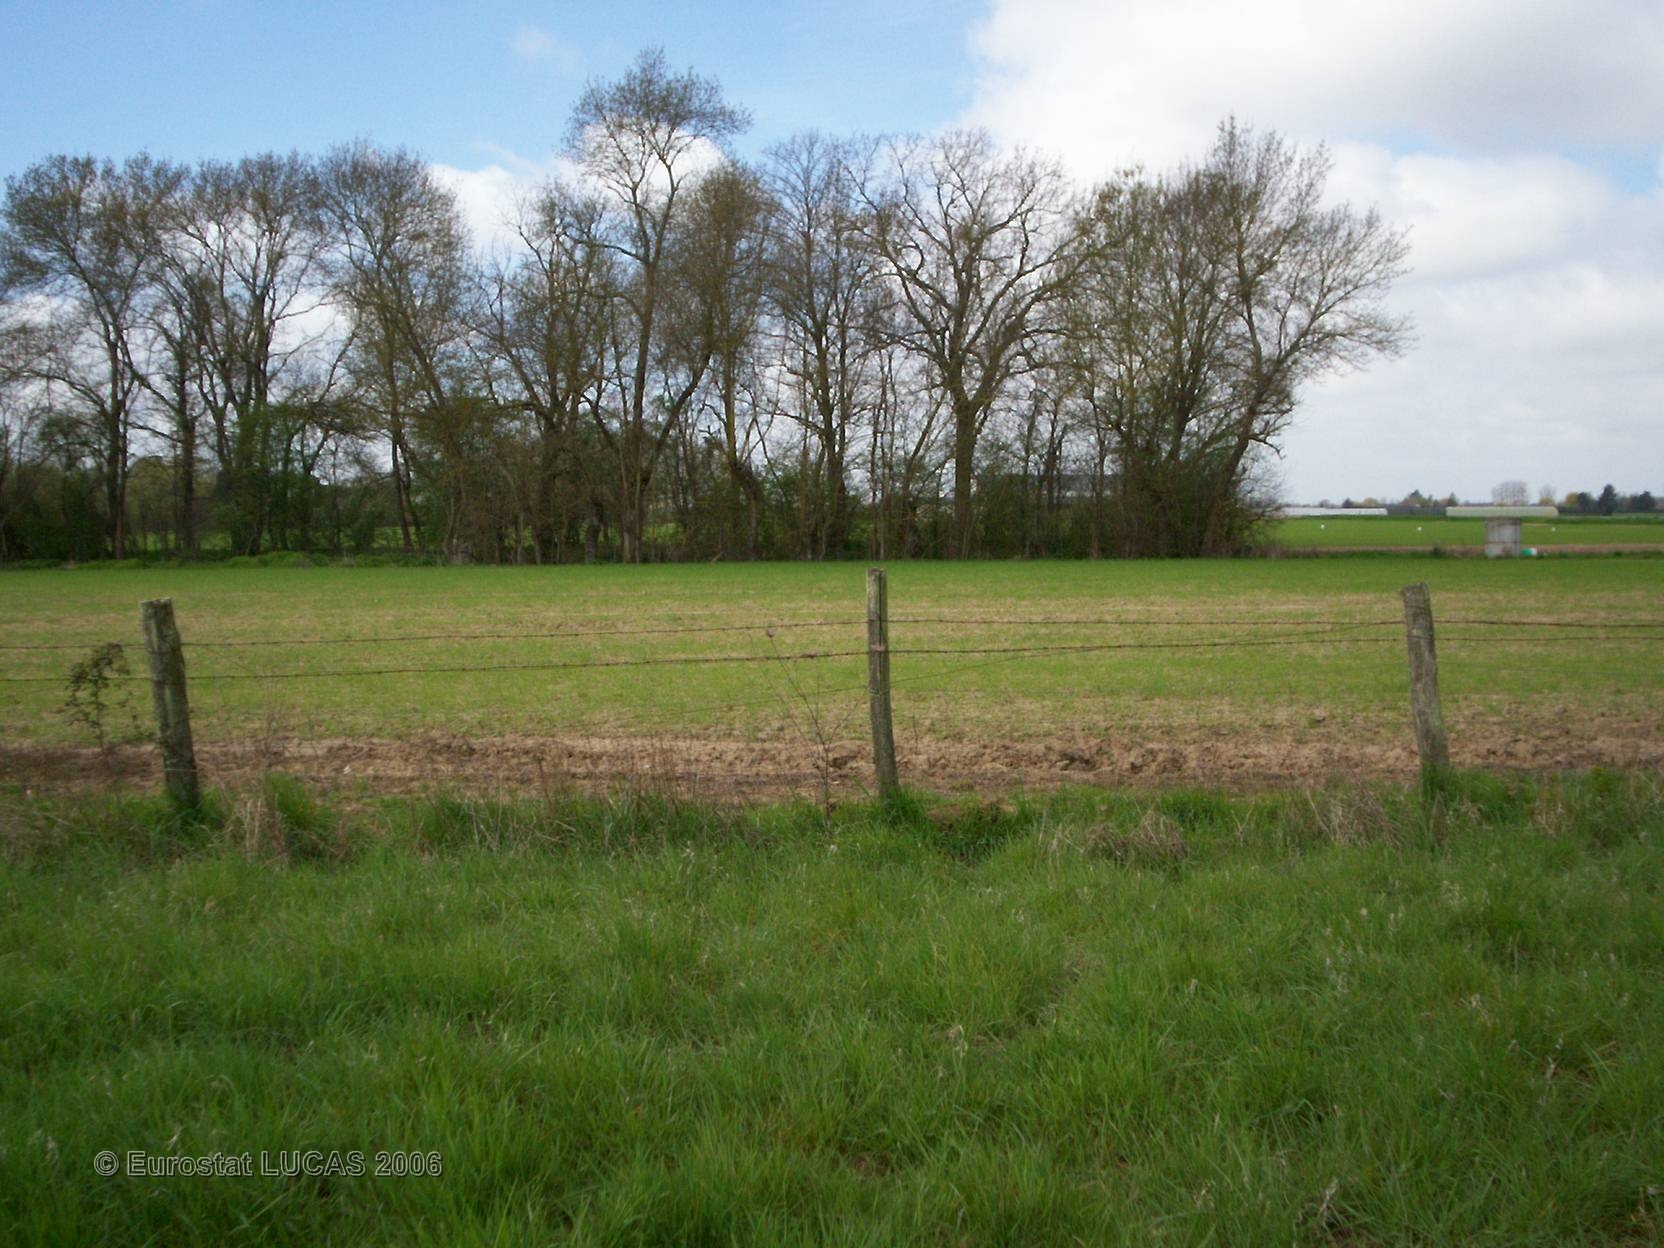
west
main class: Grassland
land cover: Grassland without tree/shrub cover
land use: Agriculture (excluding fallow land and kitchen gardens)
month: April
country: FR
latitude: 47.4210
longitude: -0.4087
